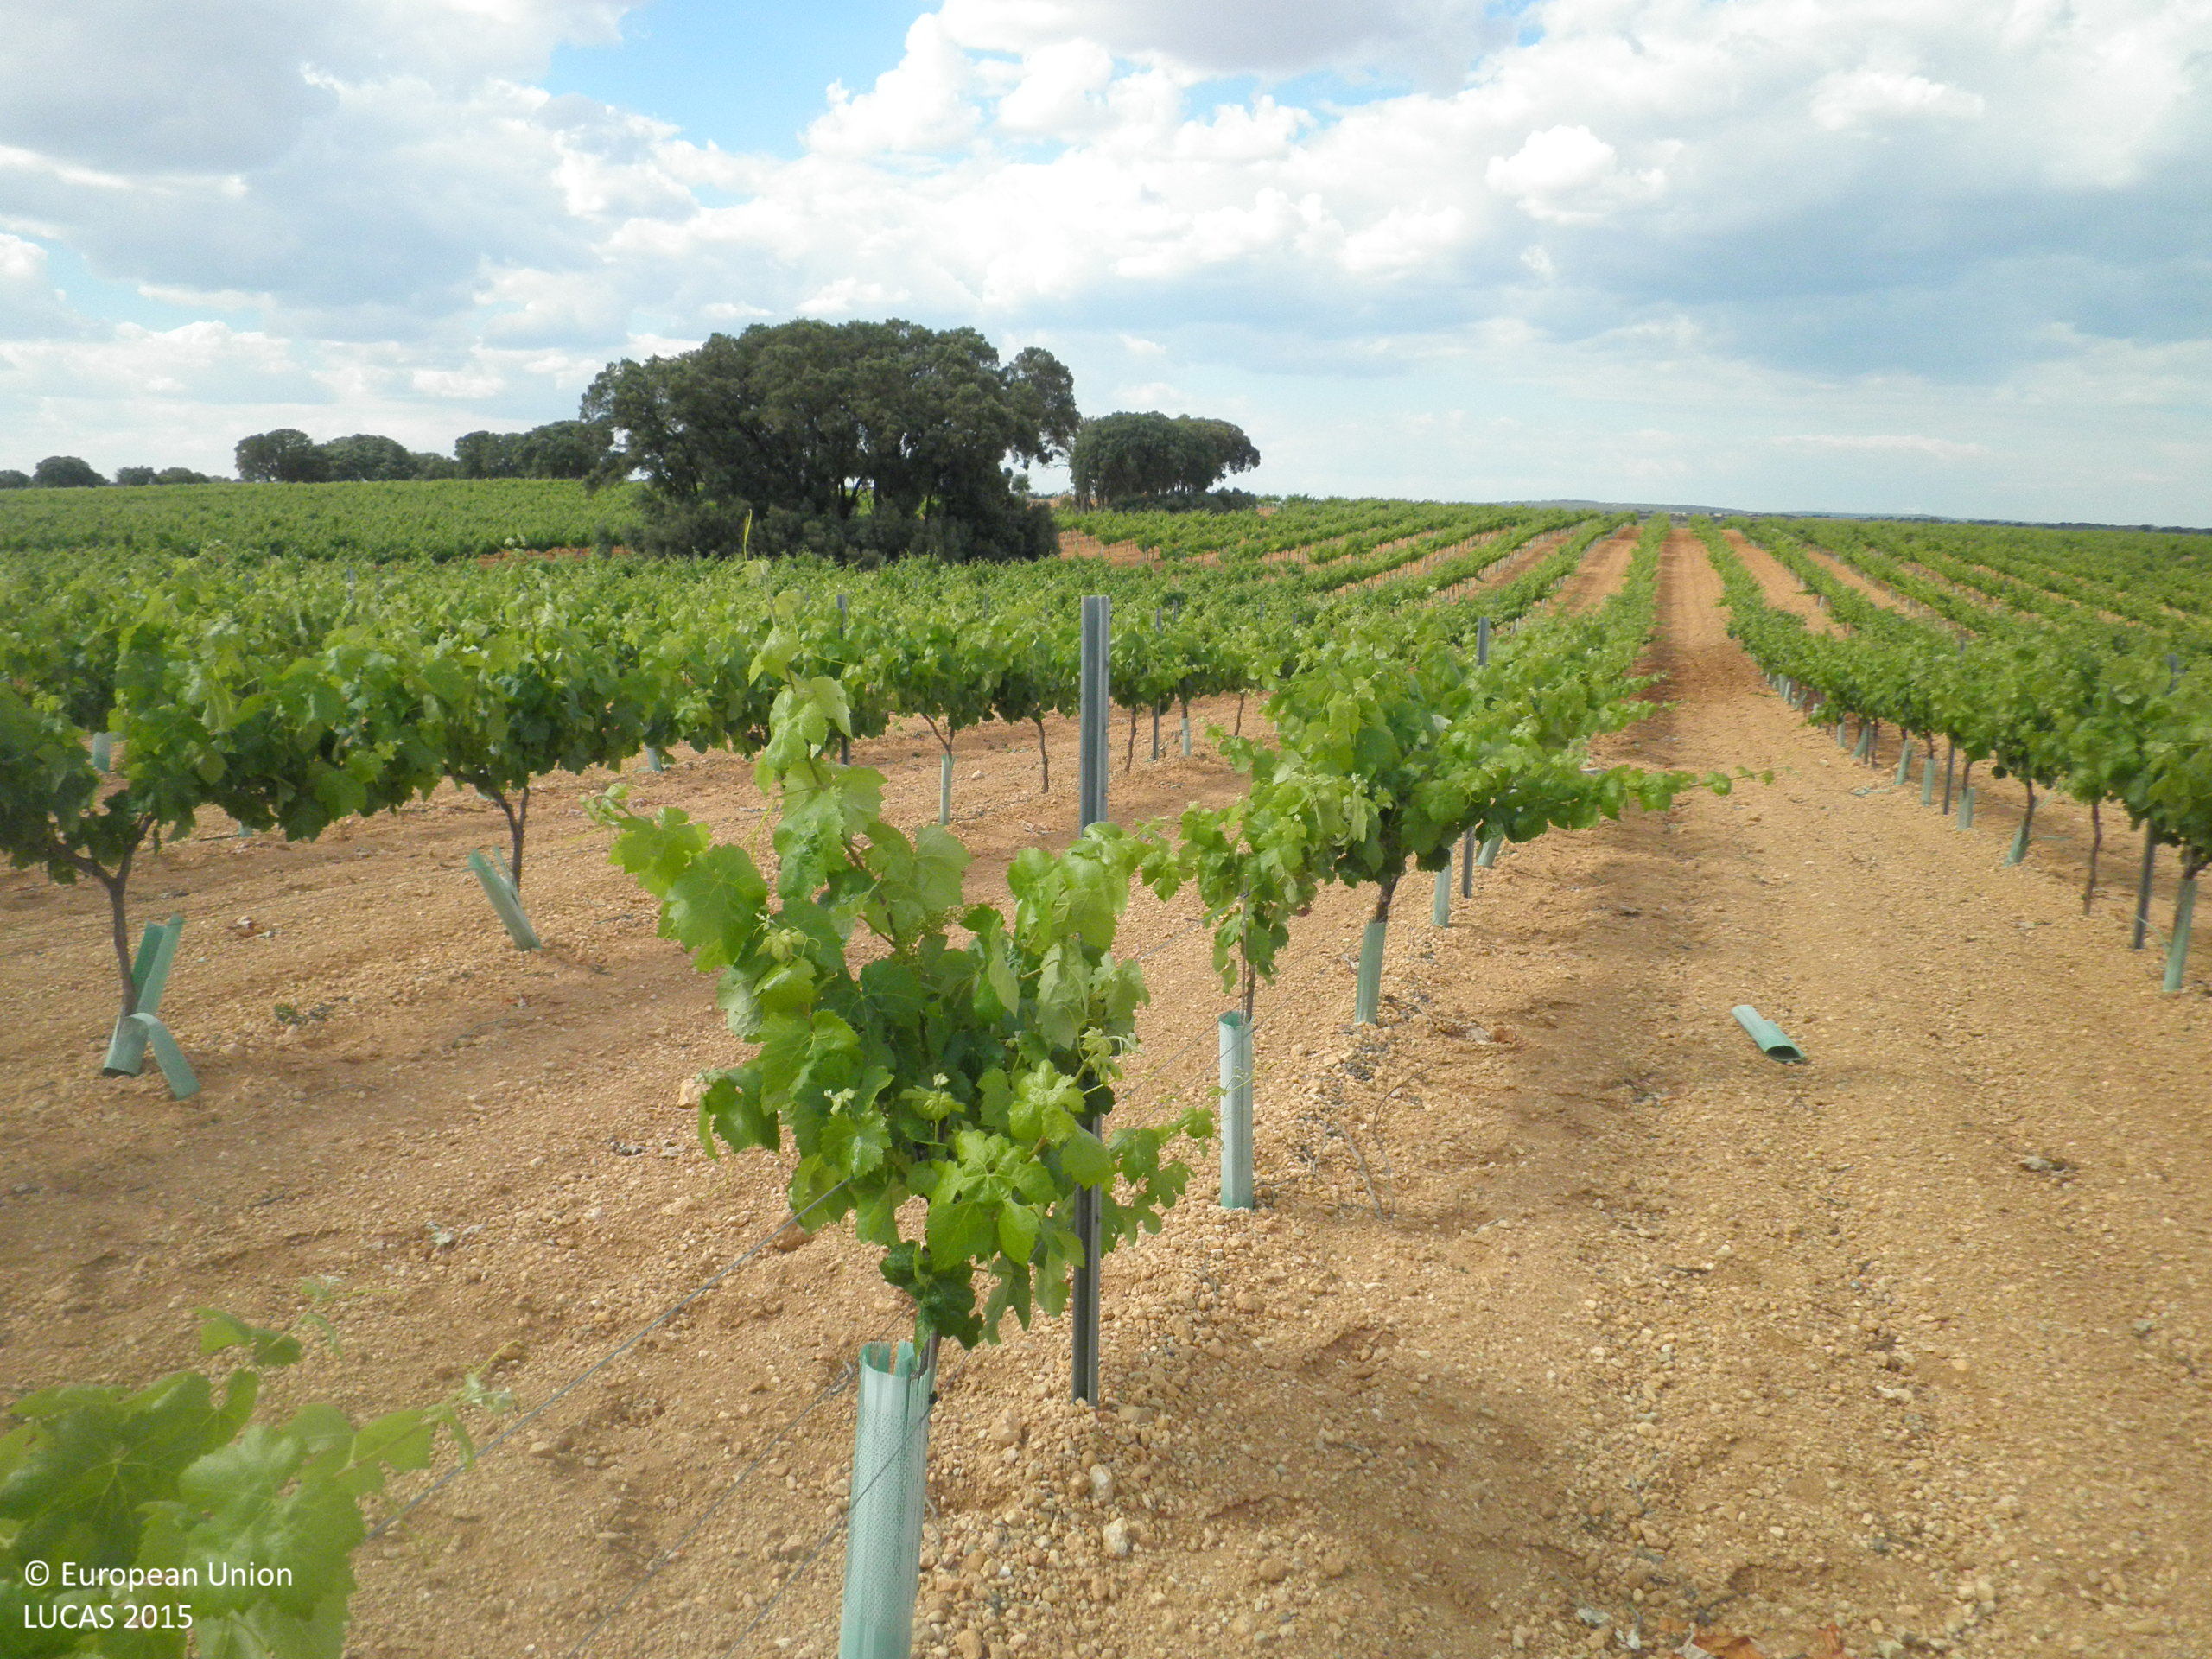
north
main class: Cropland
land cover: Vineyards
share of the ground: < 10 %
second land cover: Other bare soil
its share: > 75 %
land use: Agriculture (excluding fallow land and kitchen gardens)
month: June
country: ES
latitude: 39.4760
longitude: -1.8287
